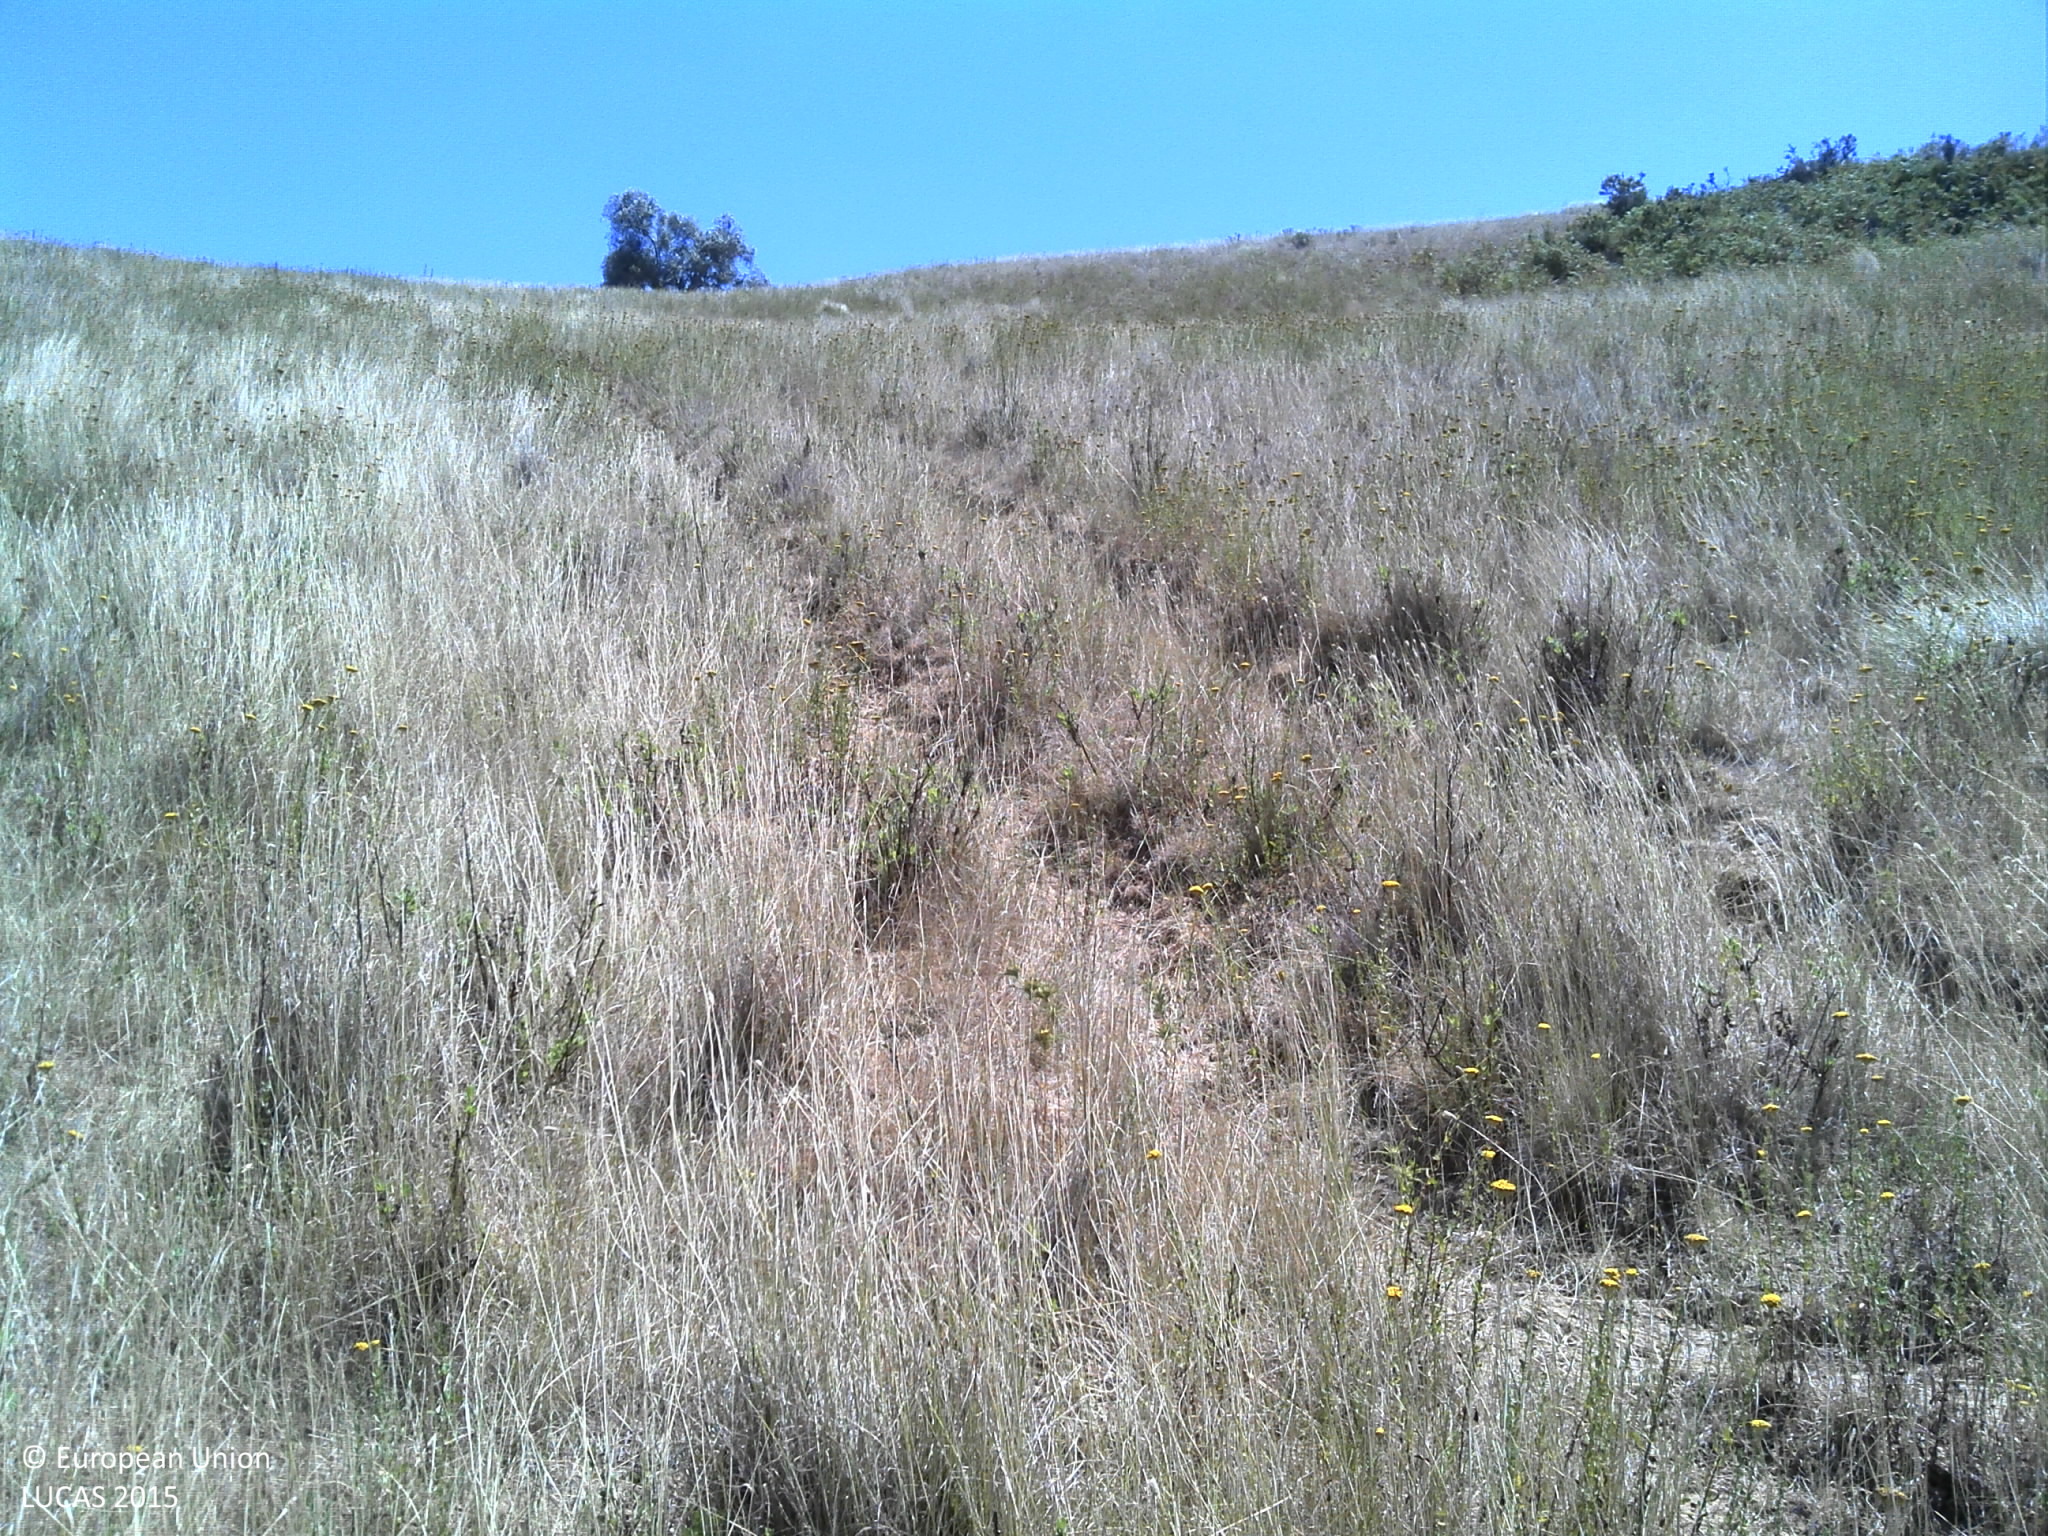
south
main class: Grassland
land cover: Grassland without tree/shrub cover
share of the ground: > 75 %
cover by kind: herbaceous plants 85 %, unconsolidated bare surface 15 %
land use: Agriculture (excluding fallow land and kitchen gardens)
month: July
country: PT
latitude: 38.9744
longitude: -9.2322
